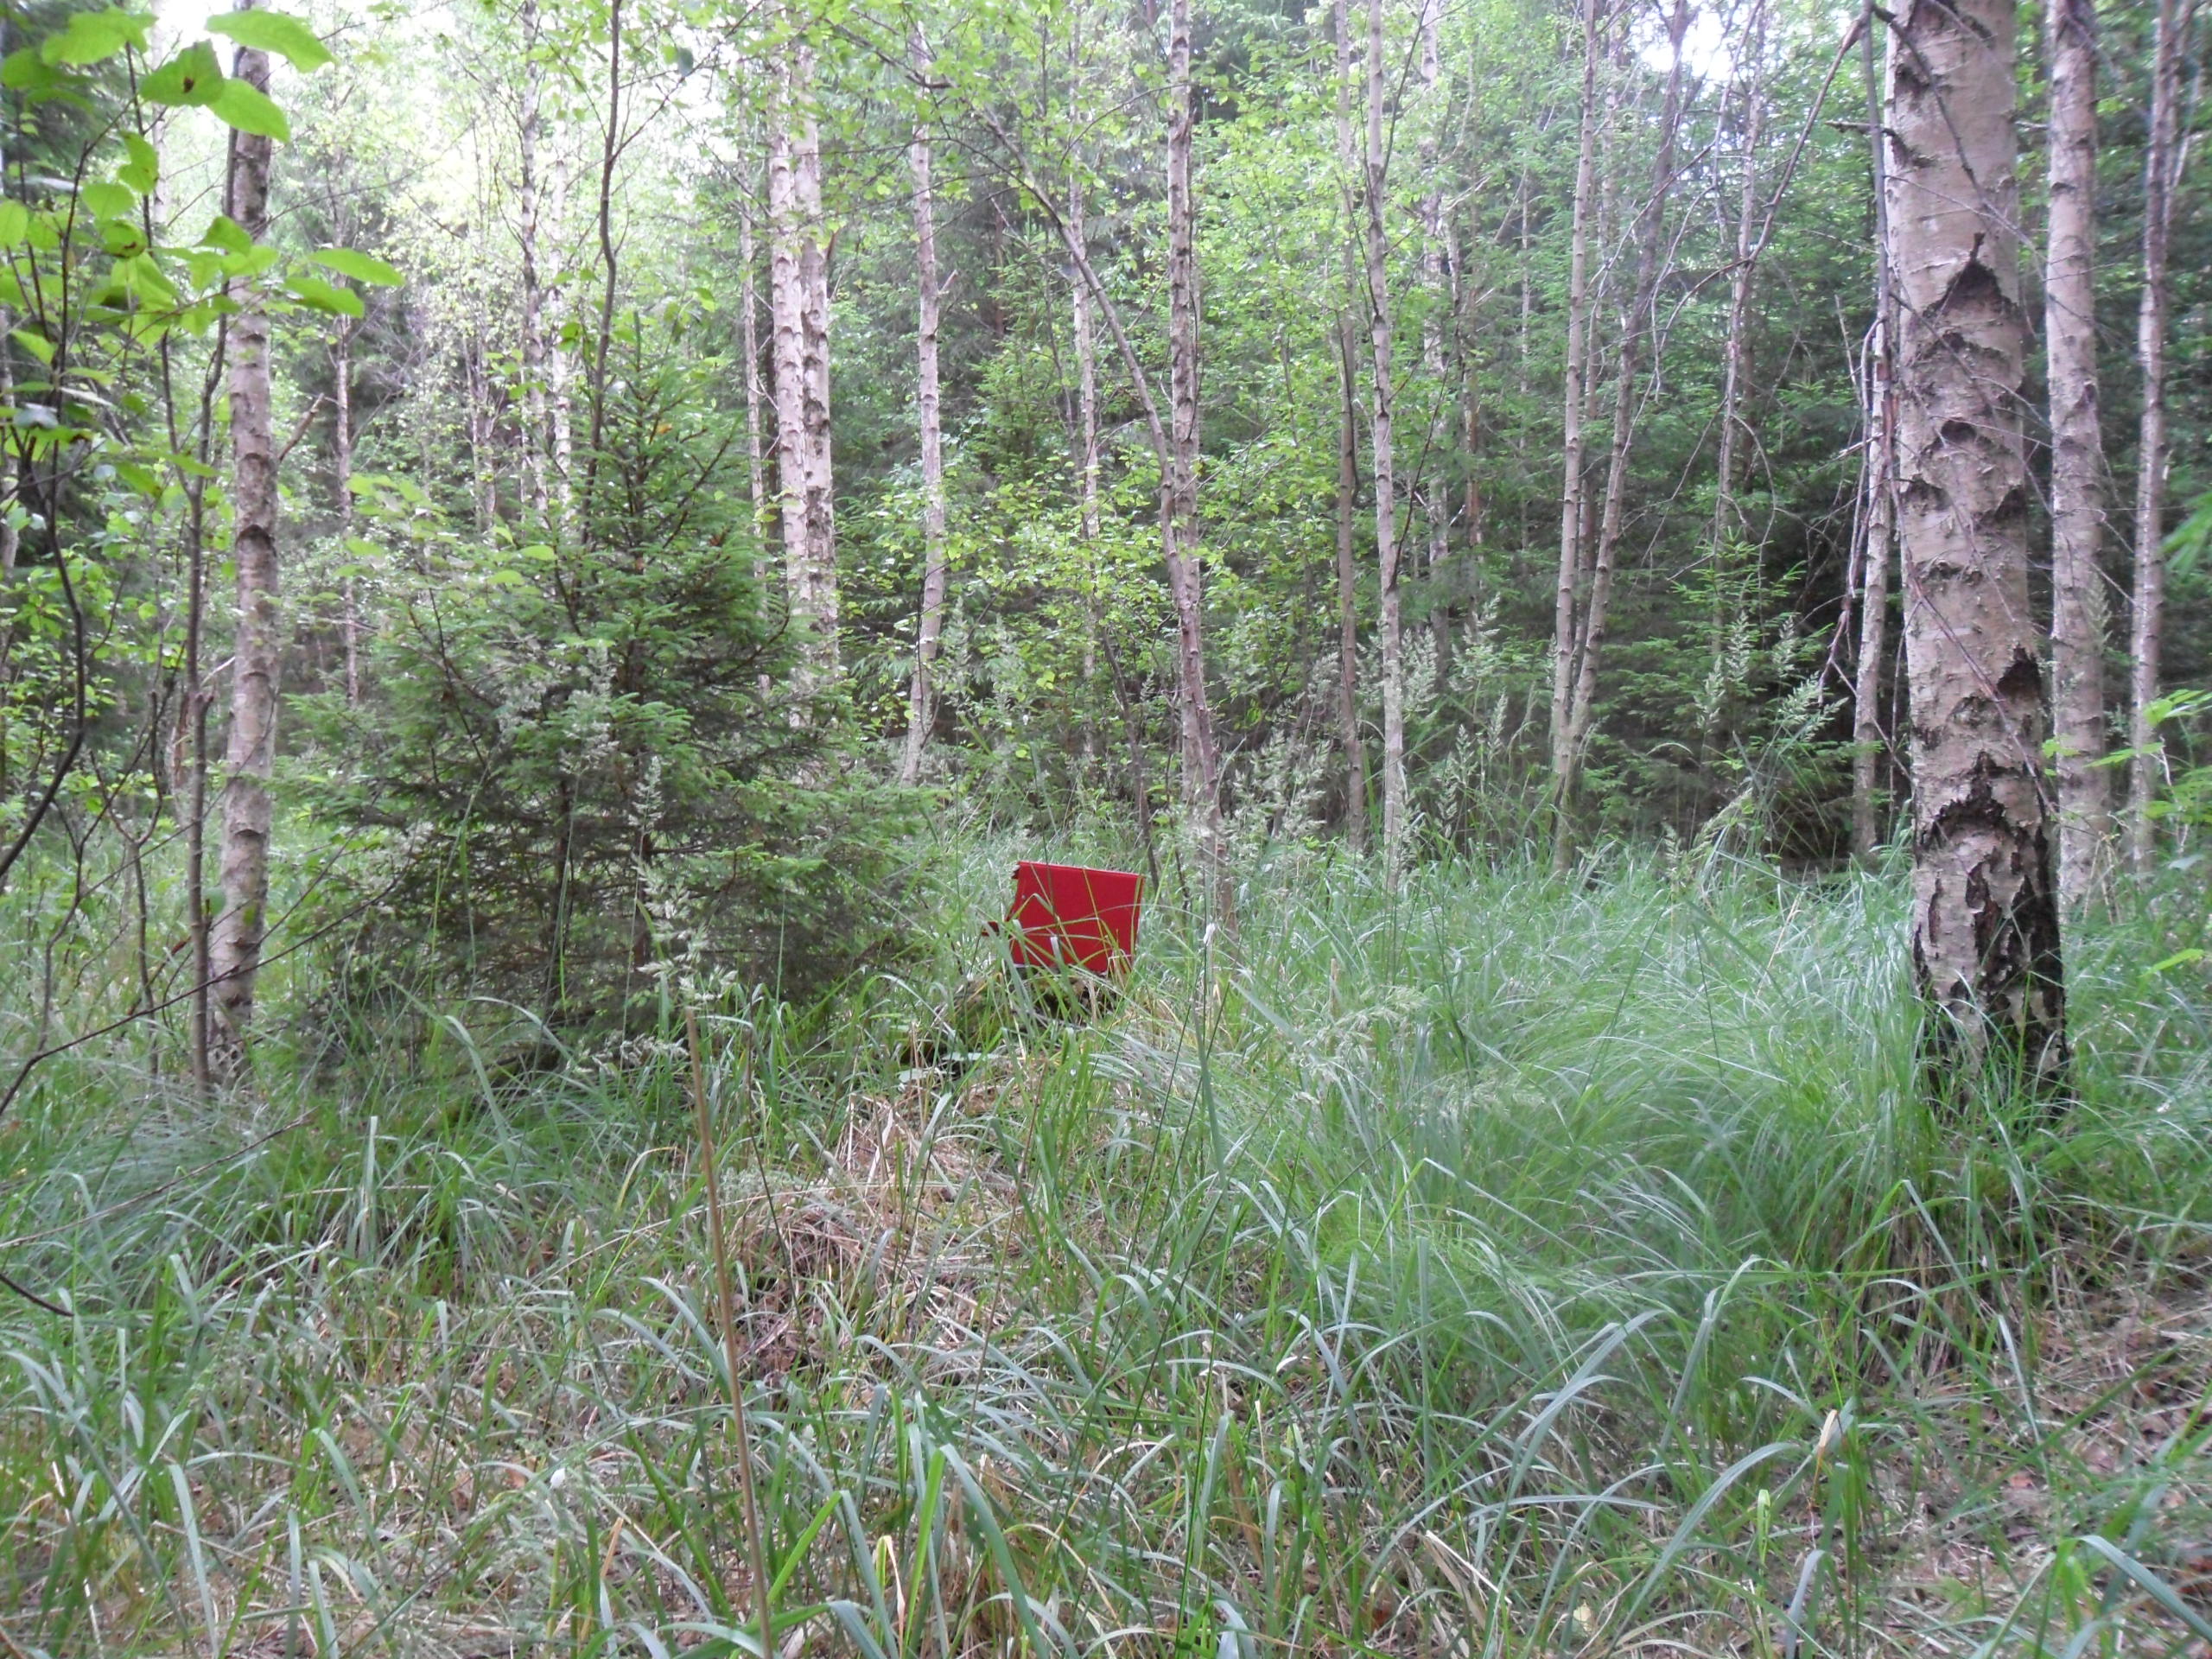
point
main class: Woodland
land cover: Spruce dominated mixed woodland
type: hemiboreal forest and nemoral coniferous forest and mixed broadleaved-coniferous forest
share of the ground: 50 - 75 %
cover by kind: coniferous forest trees 35 %, broadleaved forest trees 35 %, herbaceous plants 20 %, shrubs 10 %
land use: Forestry
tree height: > 5 m
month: July
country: LV
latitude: 57.1409
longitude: 22.4979
